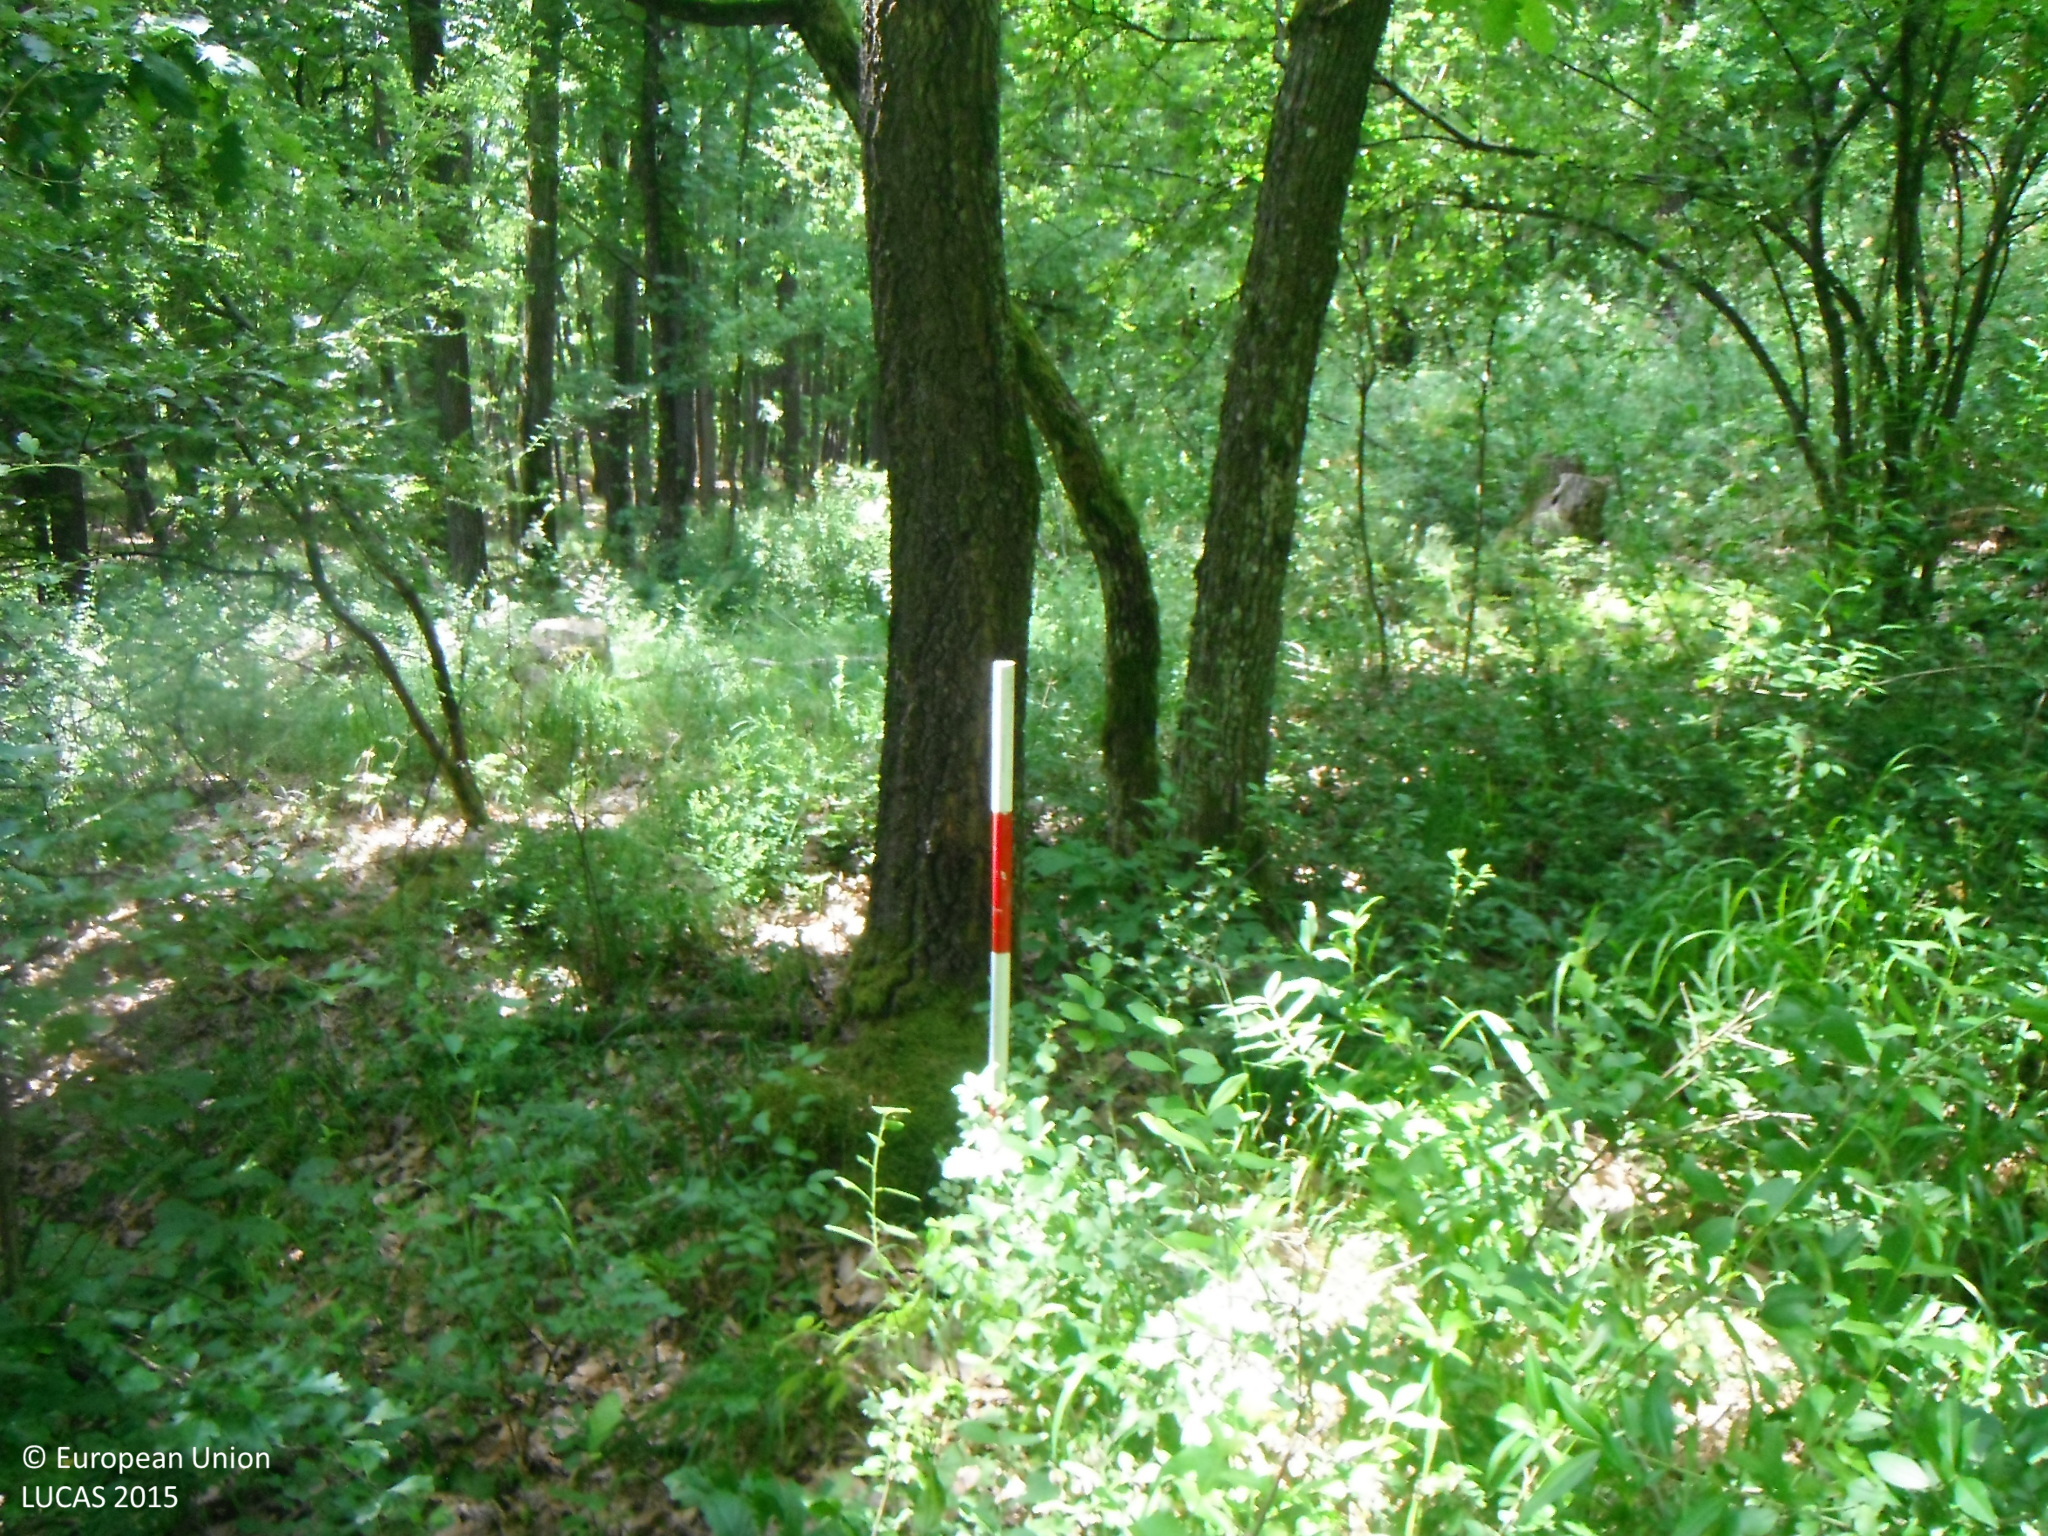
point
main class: Woodland
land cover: Broadleaved woodland
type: acidophilous oak and oak-birch forest
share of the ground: > 75 %
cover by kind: broadleaved forest trees 80 %, shrubs 15 %, herbaceous plants 5 %
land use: Forestry
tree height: > 5 m
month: June
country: SK
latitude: 48.3015
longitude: 19.5016
